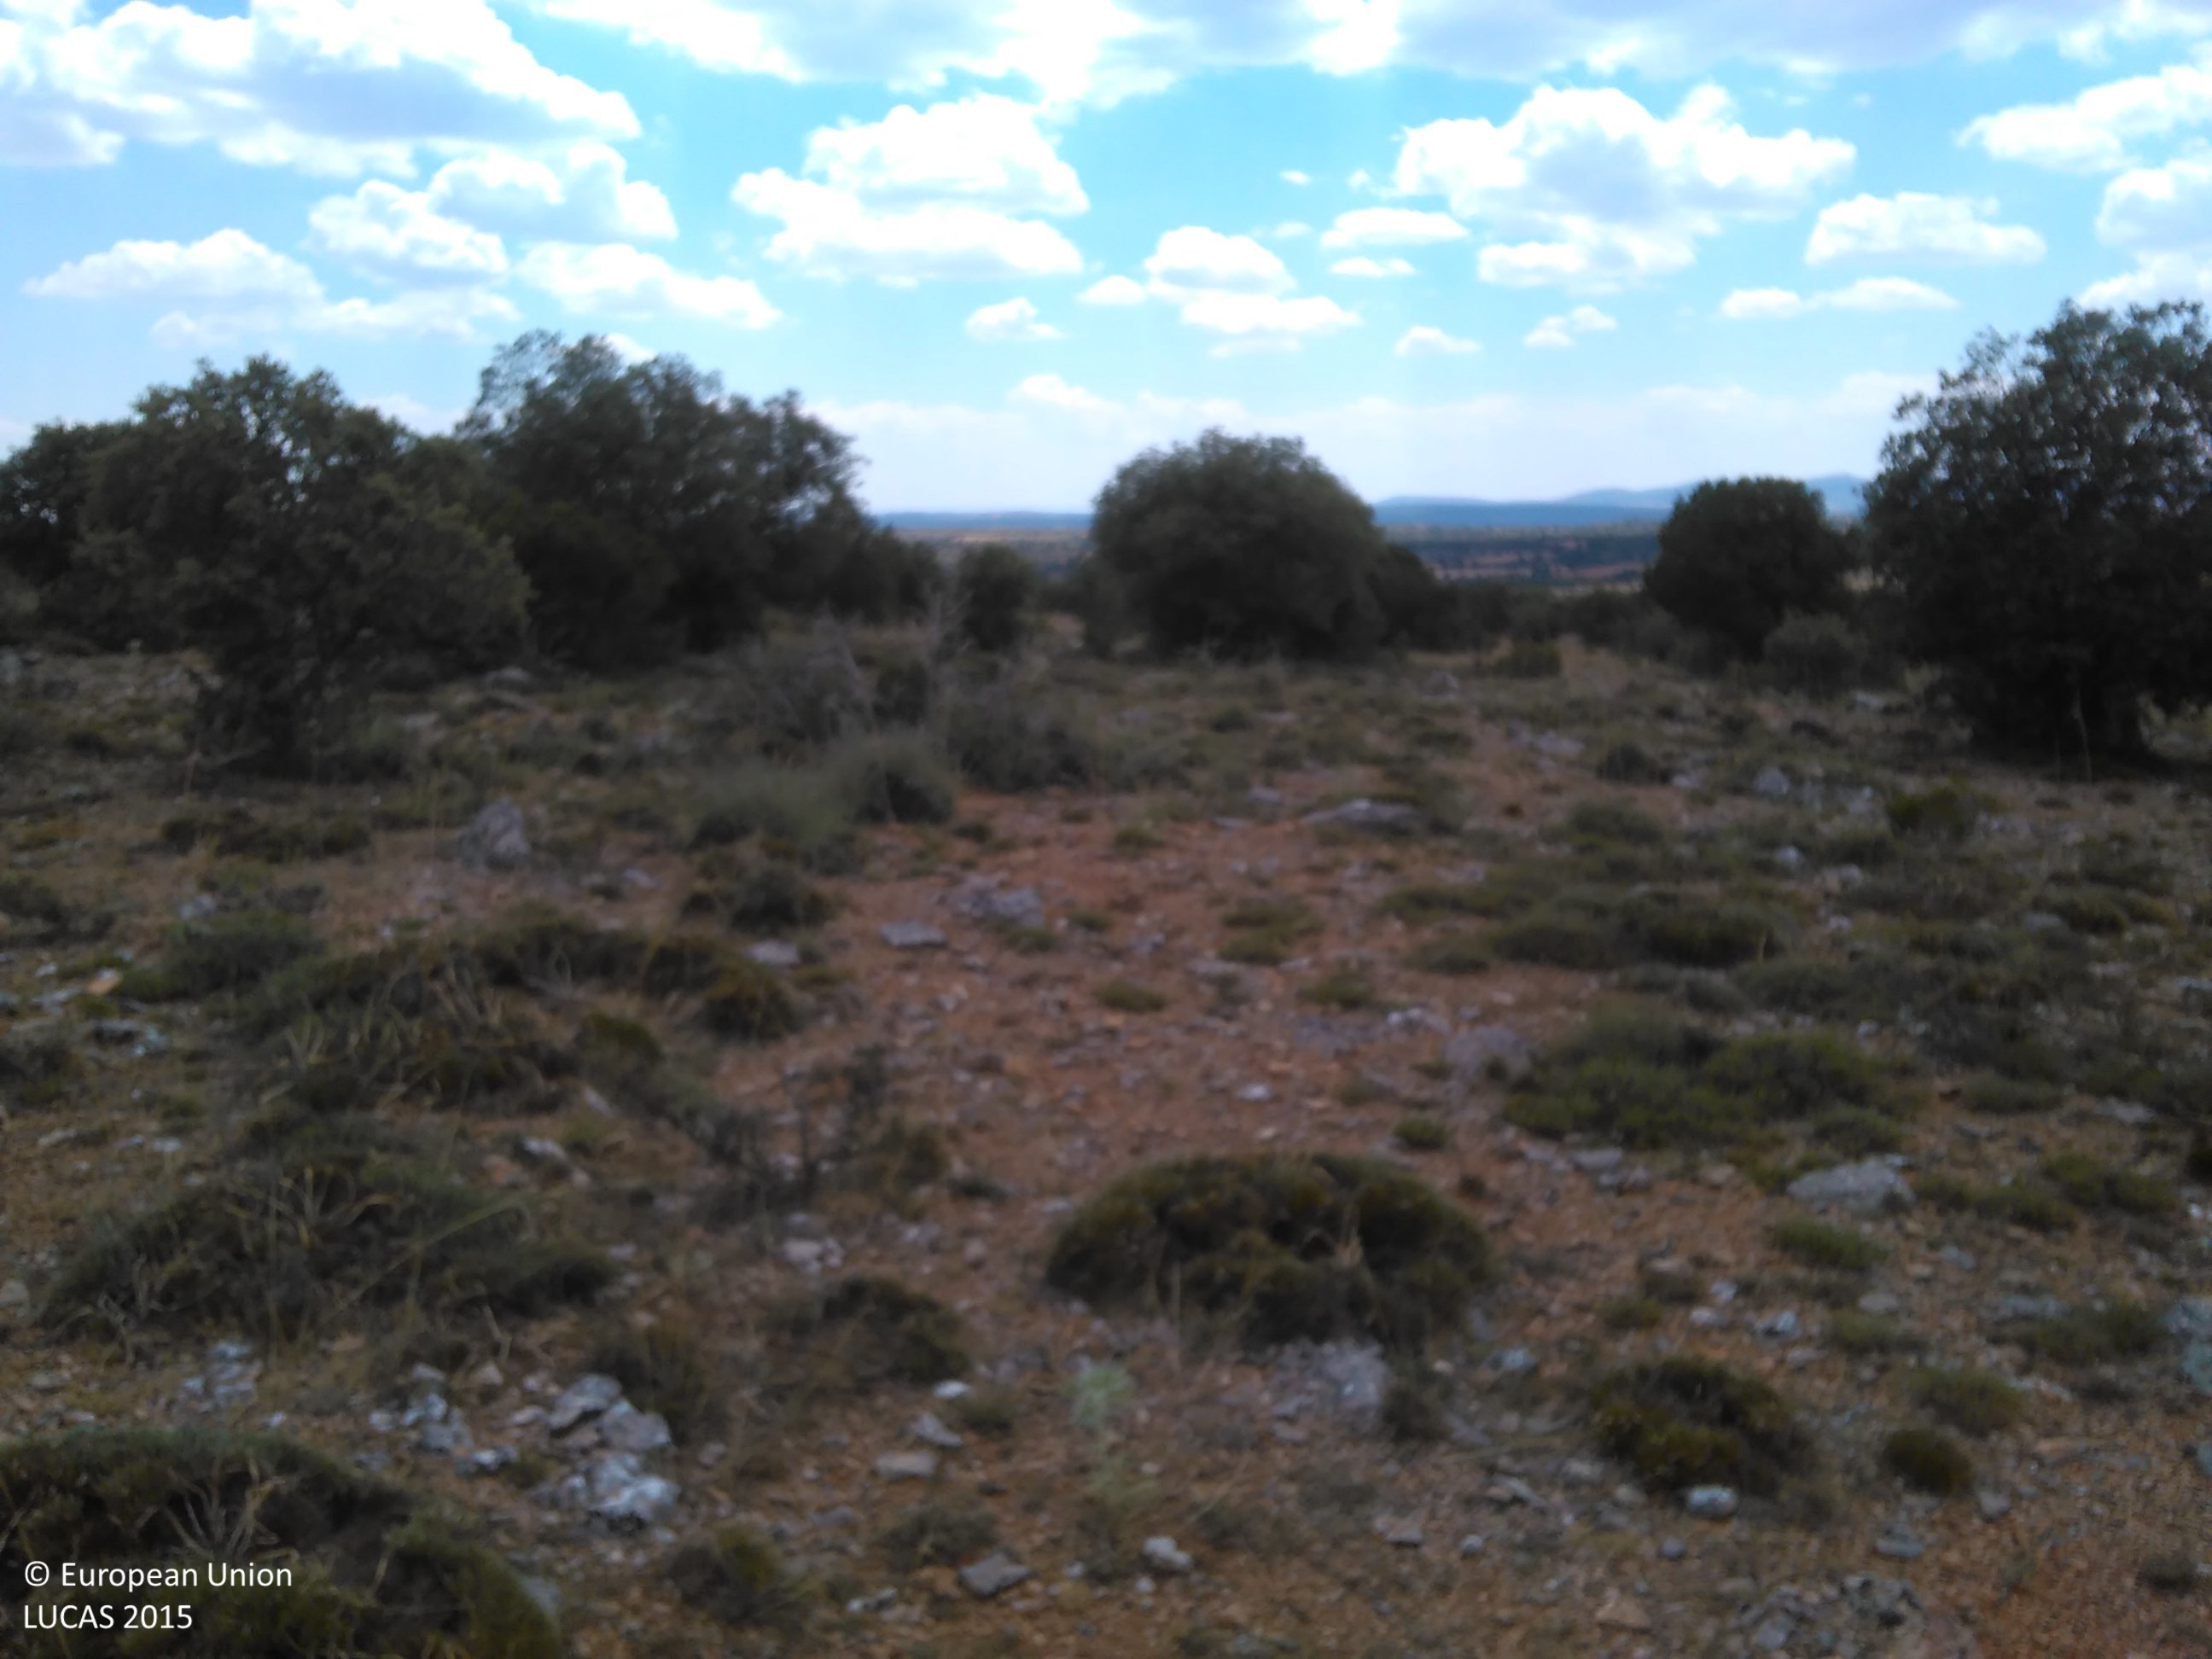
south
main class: Shrubland
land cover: Shrubland with sparse tree cover
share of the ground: 25 - 50 %
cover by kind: unconsolidated bare surface 50 %, shrubs 35 %, herbaceous plants 10 %, broadleaved forest trees 5 %
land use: Semi-natural and natural areas not in use
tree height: < 5 m
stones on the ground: > 50 %
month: July
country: ES
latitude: 41.6186
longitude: -1.9240
